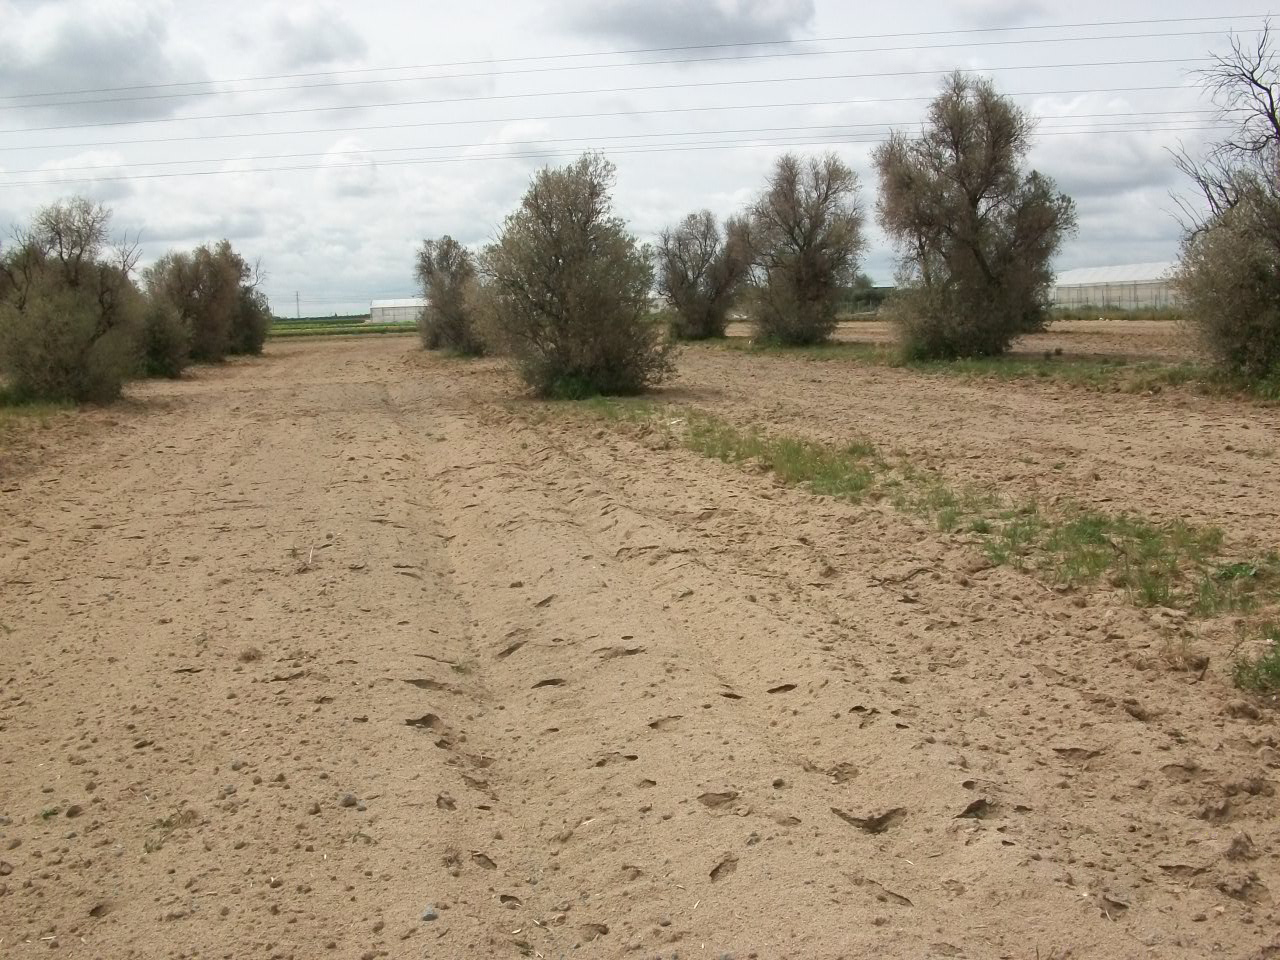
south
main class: Cropland
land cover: Olive groves
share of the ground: 25 - 50 %
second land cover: Other bare soil
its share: > 75 %
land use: Agriculture (excluding fallow land and kitchen gardens)
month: April
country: ES
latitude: 40.2896
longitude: -3.8358
